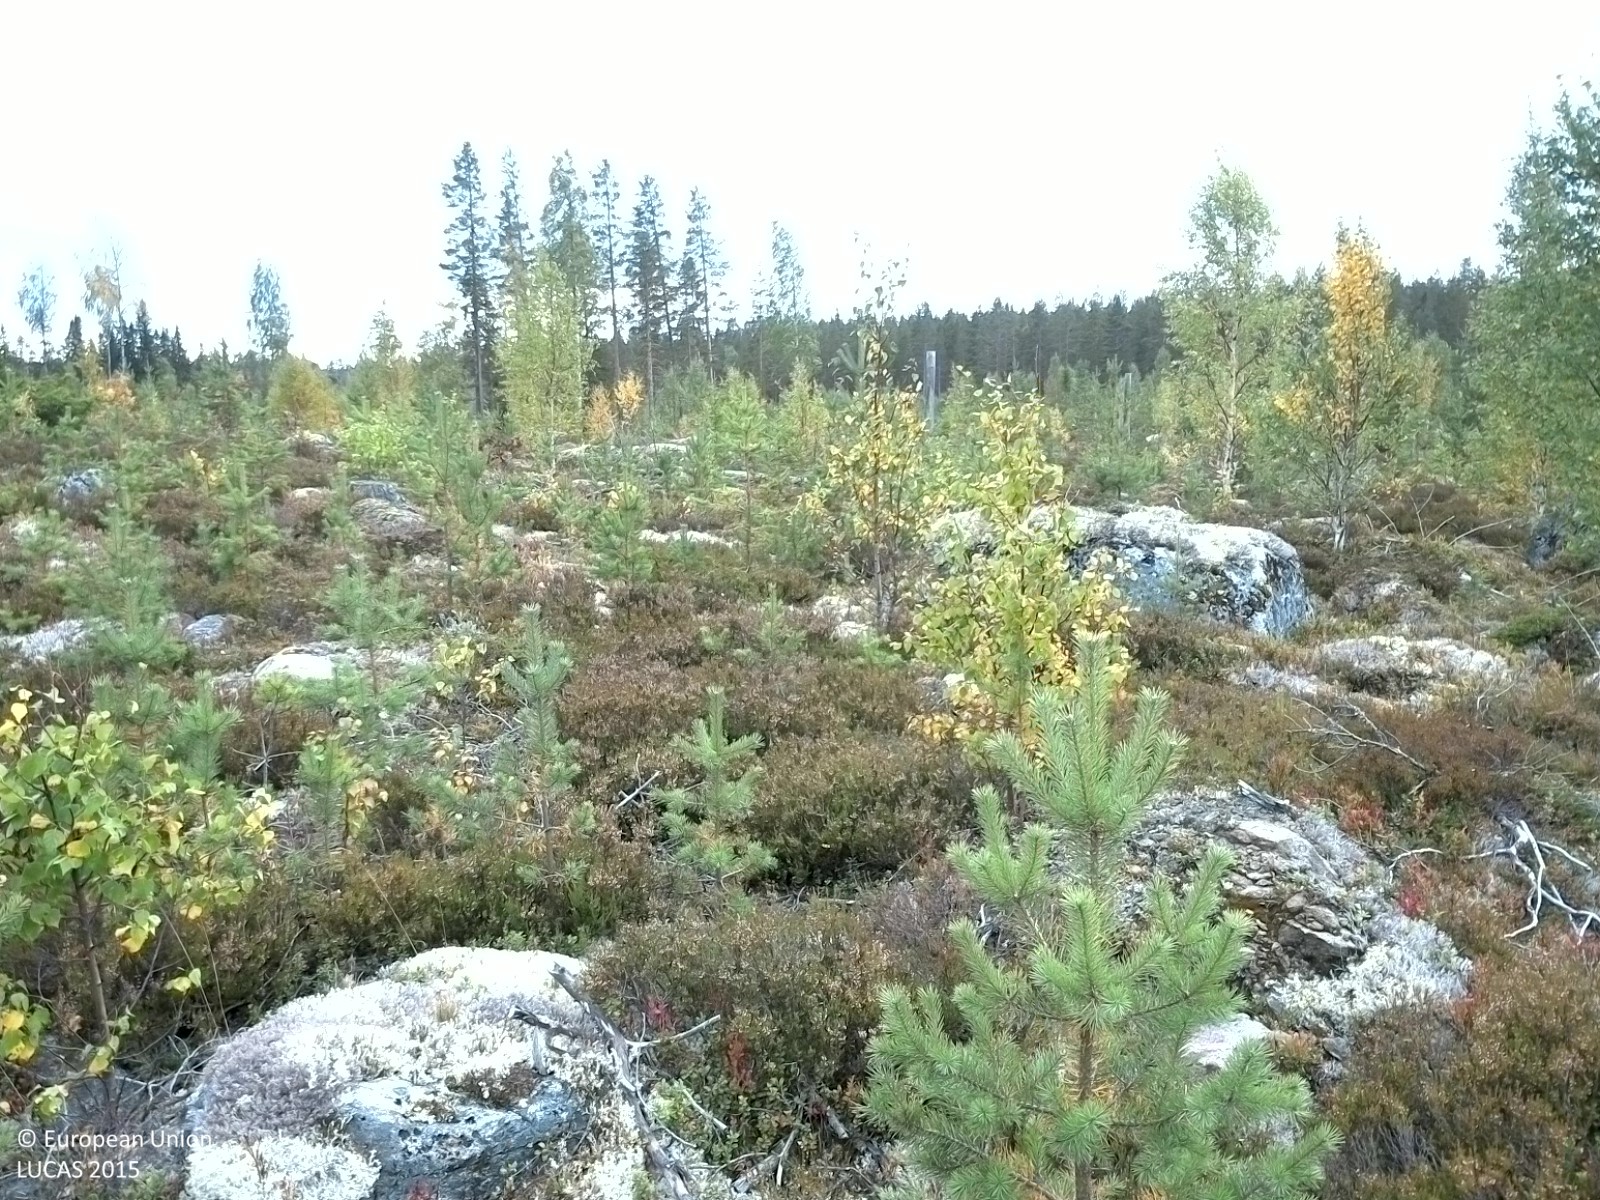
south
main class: Woodland
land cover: Other mixed woodland
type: boreal forest
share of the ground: 10 - 25 %
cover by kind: shrubs 60 %, consolidated bare surface 20 %, lichens and mosses 10 %, coniferous forest trees 5 %, broadleaved forest trees 5 %
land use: Forestry
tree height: < 5 m
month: September
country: SE
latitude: 62.3276
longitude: 15.5971
